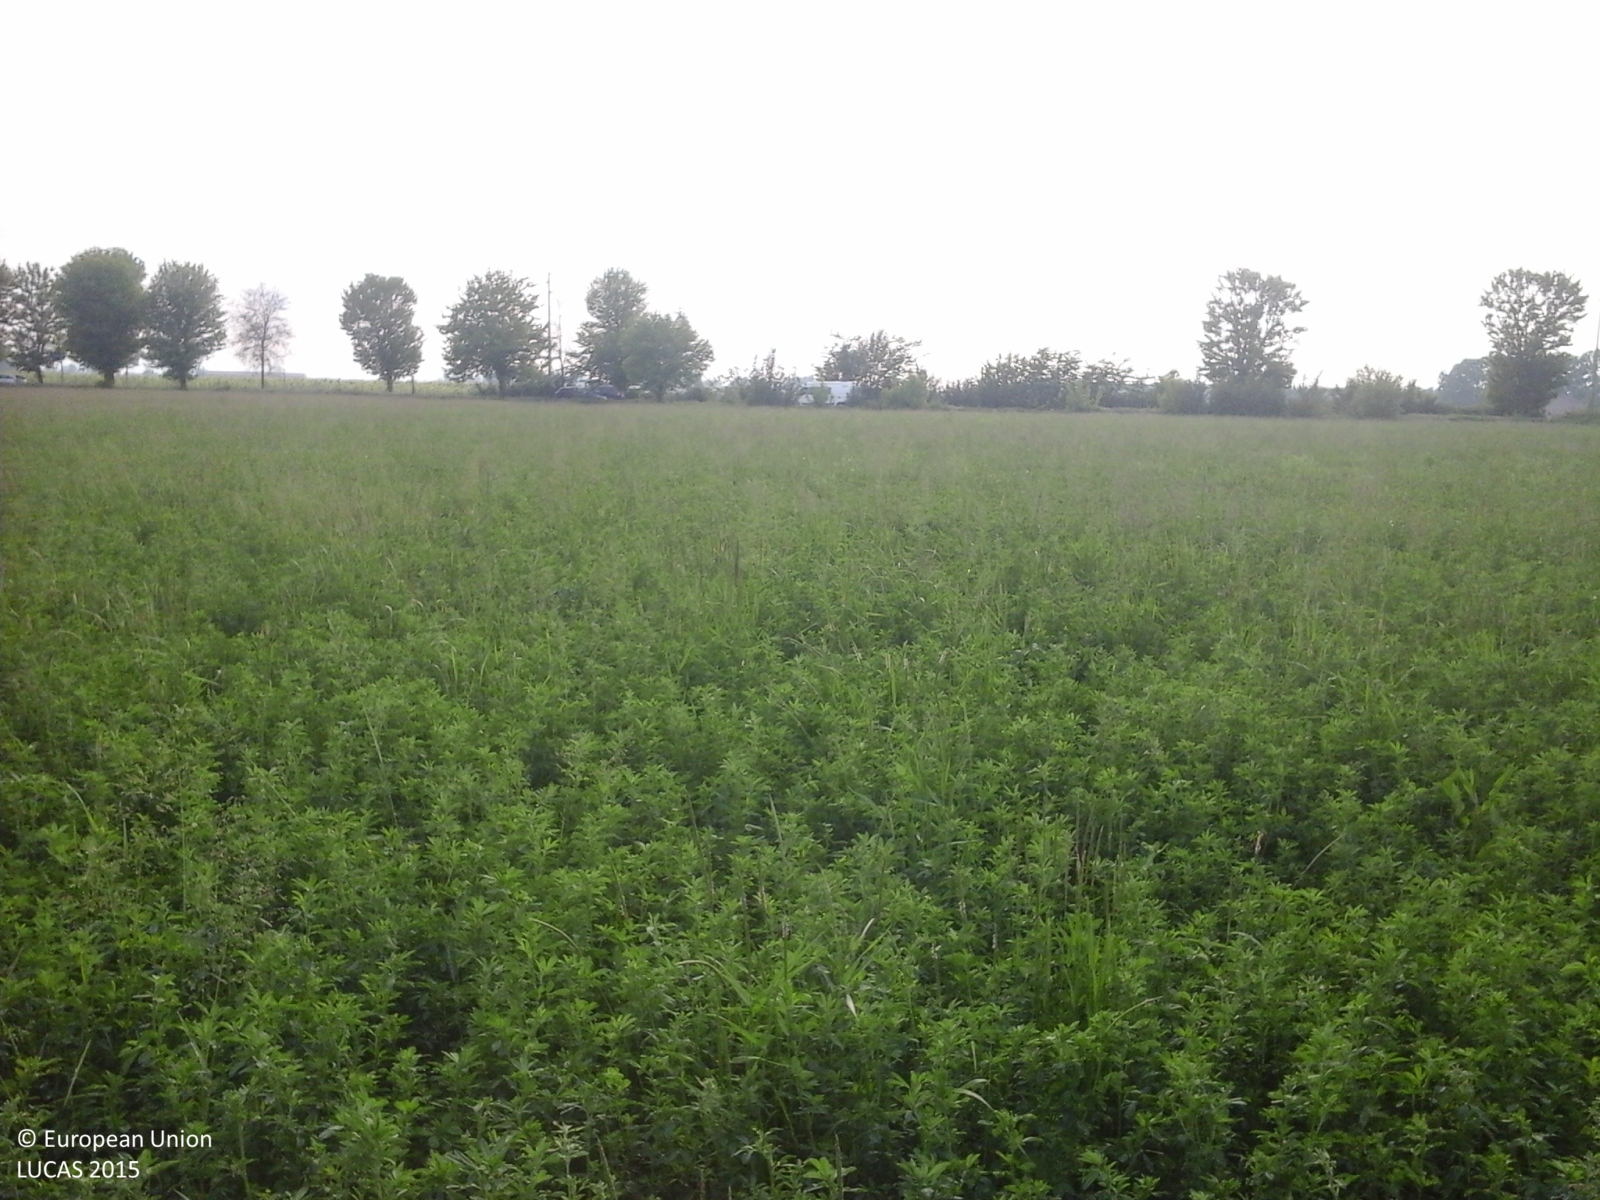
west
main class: Cropland
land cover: Lucerne
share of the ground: > 75 %
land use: Agriculture (excluding fallow land and kitchen gardens)
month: April
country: IT
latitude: 44.6894
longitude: 10.8940
